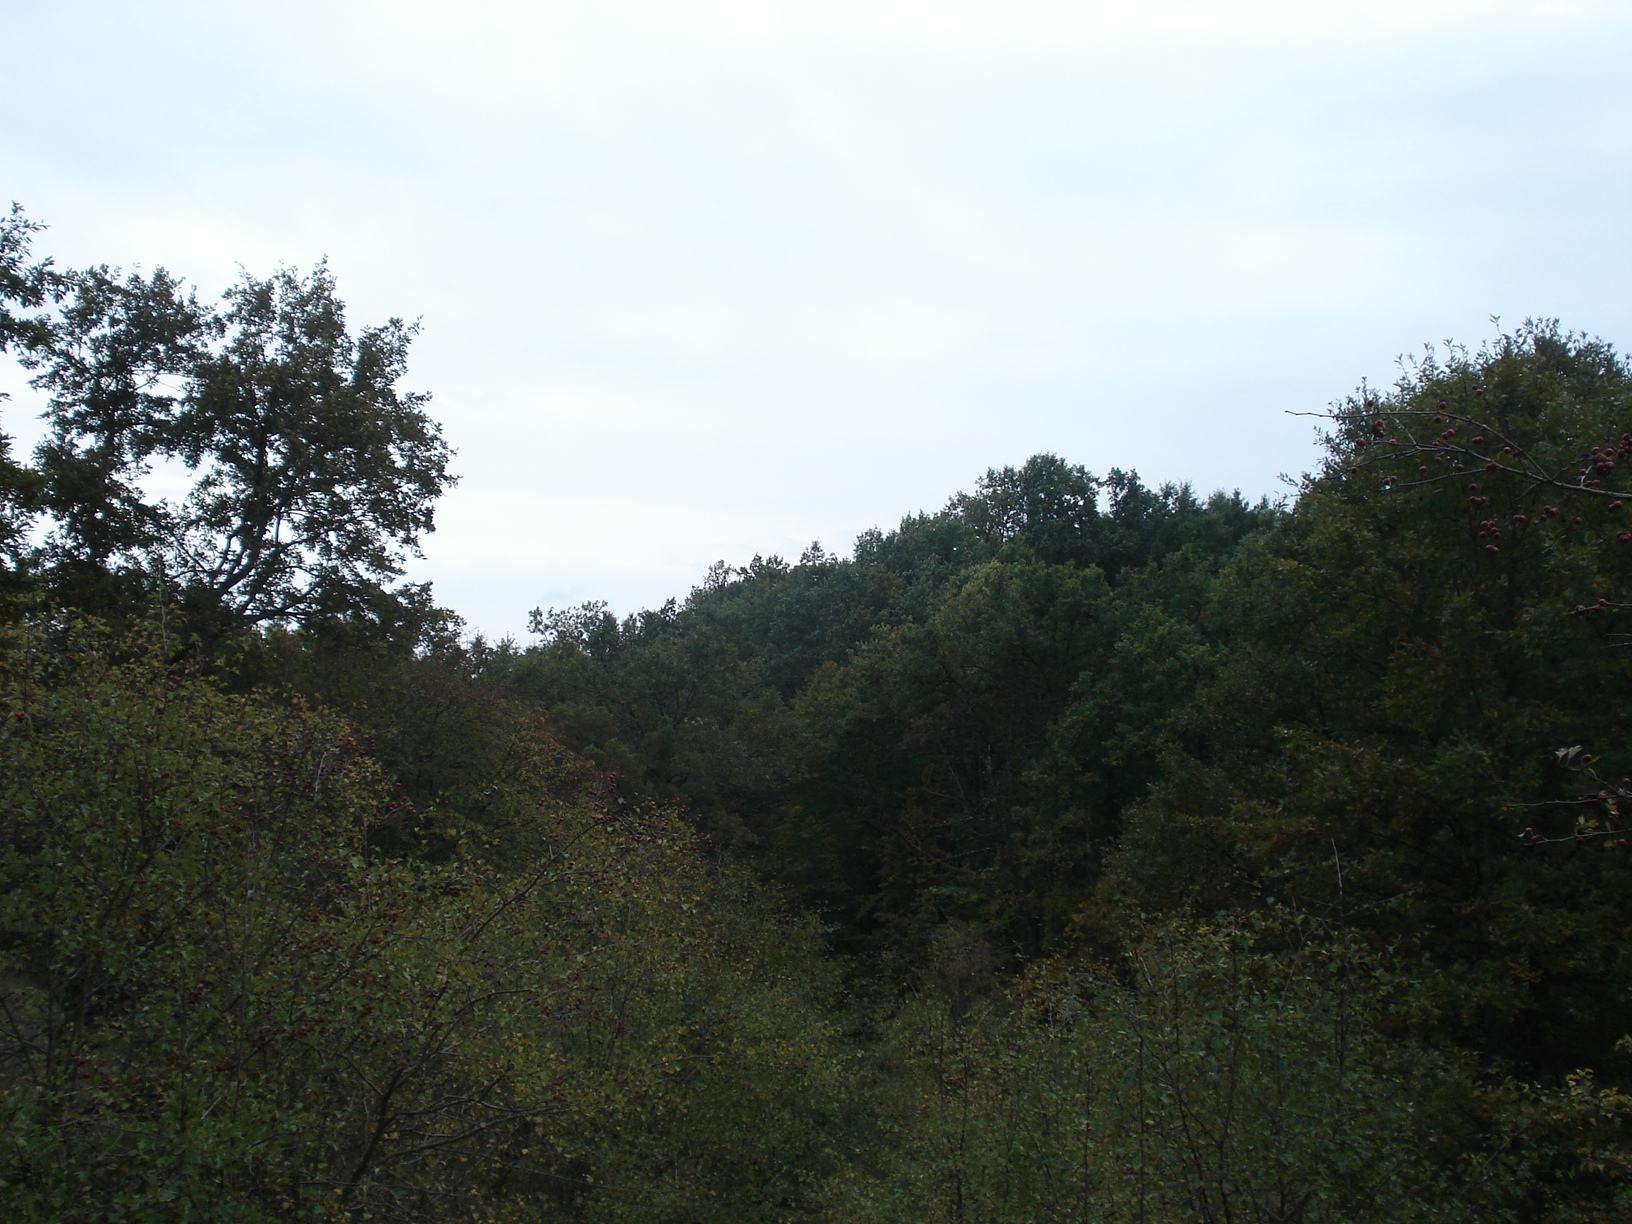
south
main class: Woodland
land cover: Broadleaved woodland
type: mesophytic deciduous forest
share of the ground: 50 - 75 %
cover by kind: broadleaved forest trees 60 %, shrubs 20 %, herbaceous plants 20 %
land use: Semi-natural and natural areas not in use
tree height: > 5 m
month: October
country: BG
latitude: 42.9273
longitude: 25.9266
